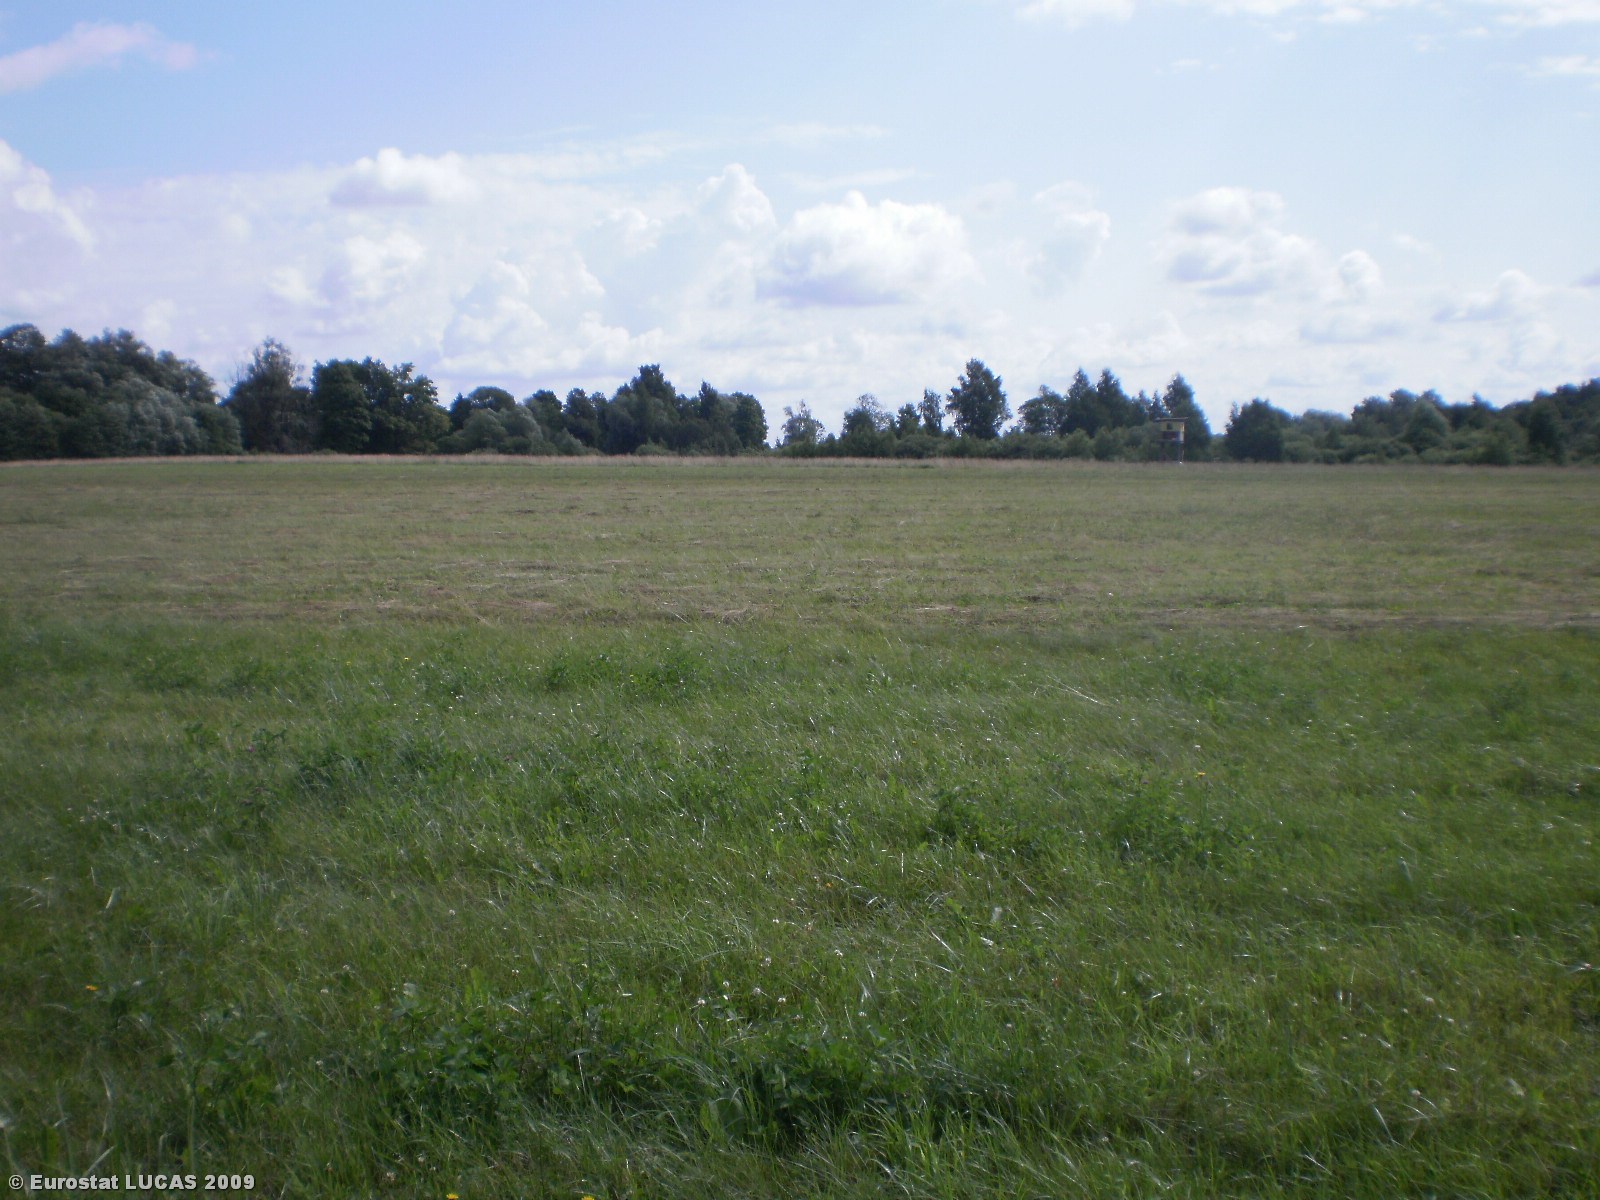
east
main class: Grassland
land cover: Grassland without tree/shrub cover
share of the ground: > 75 %
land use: Agriculture (excluding fallow land and kitchen gardens)
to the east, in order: Grassland without tree/shrub cover; Broadleaved woodland
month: July
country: LT
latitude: 56.0322
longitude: 25.1505
